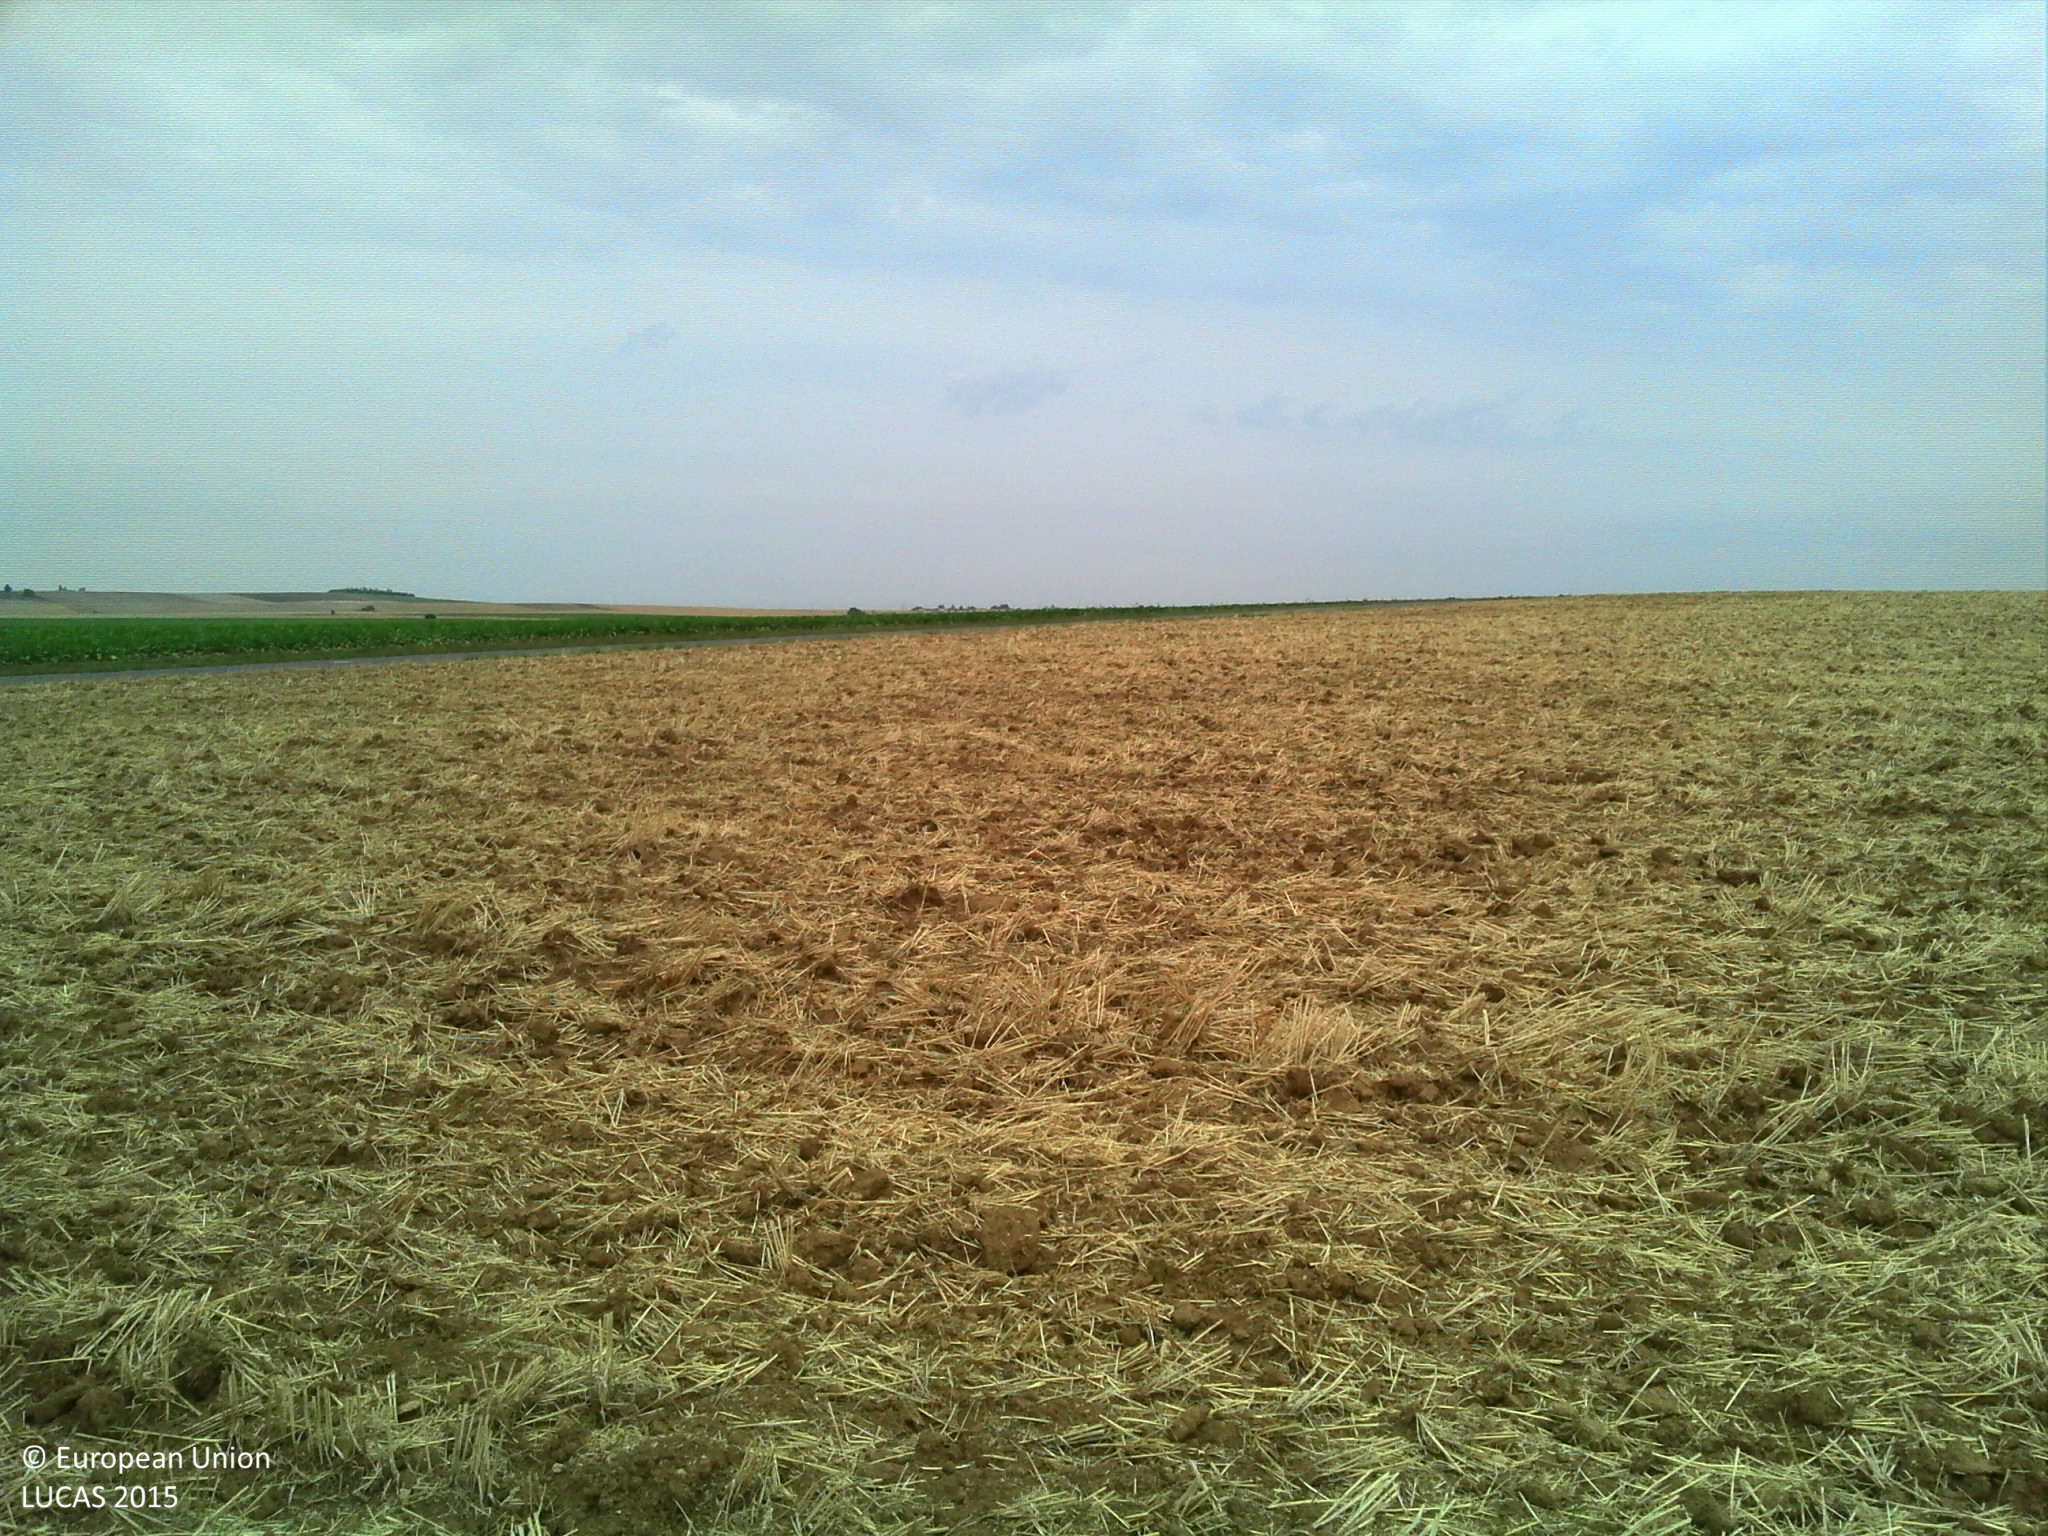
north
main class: Cropland
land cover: Common wheat
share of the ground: 25 - 50 %
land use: Agriculture (excluding fallow land and kitchen gardens)
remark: Harvested field
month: August
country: FR
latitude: 48.2061
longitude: 2.5490
